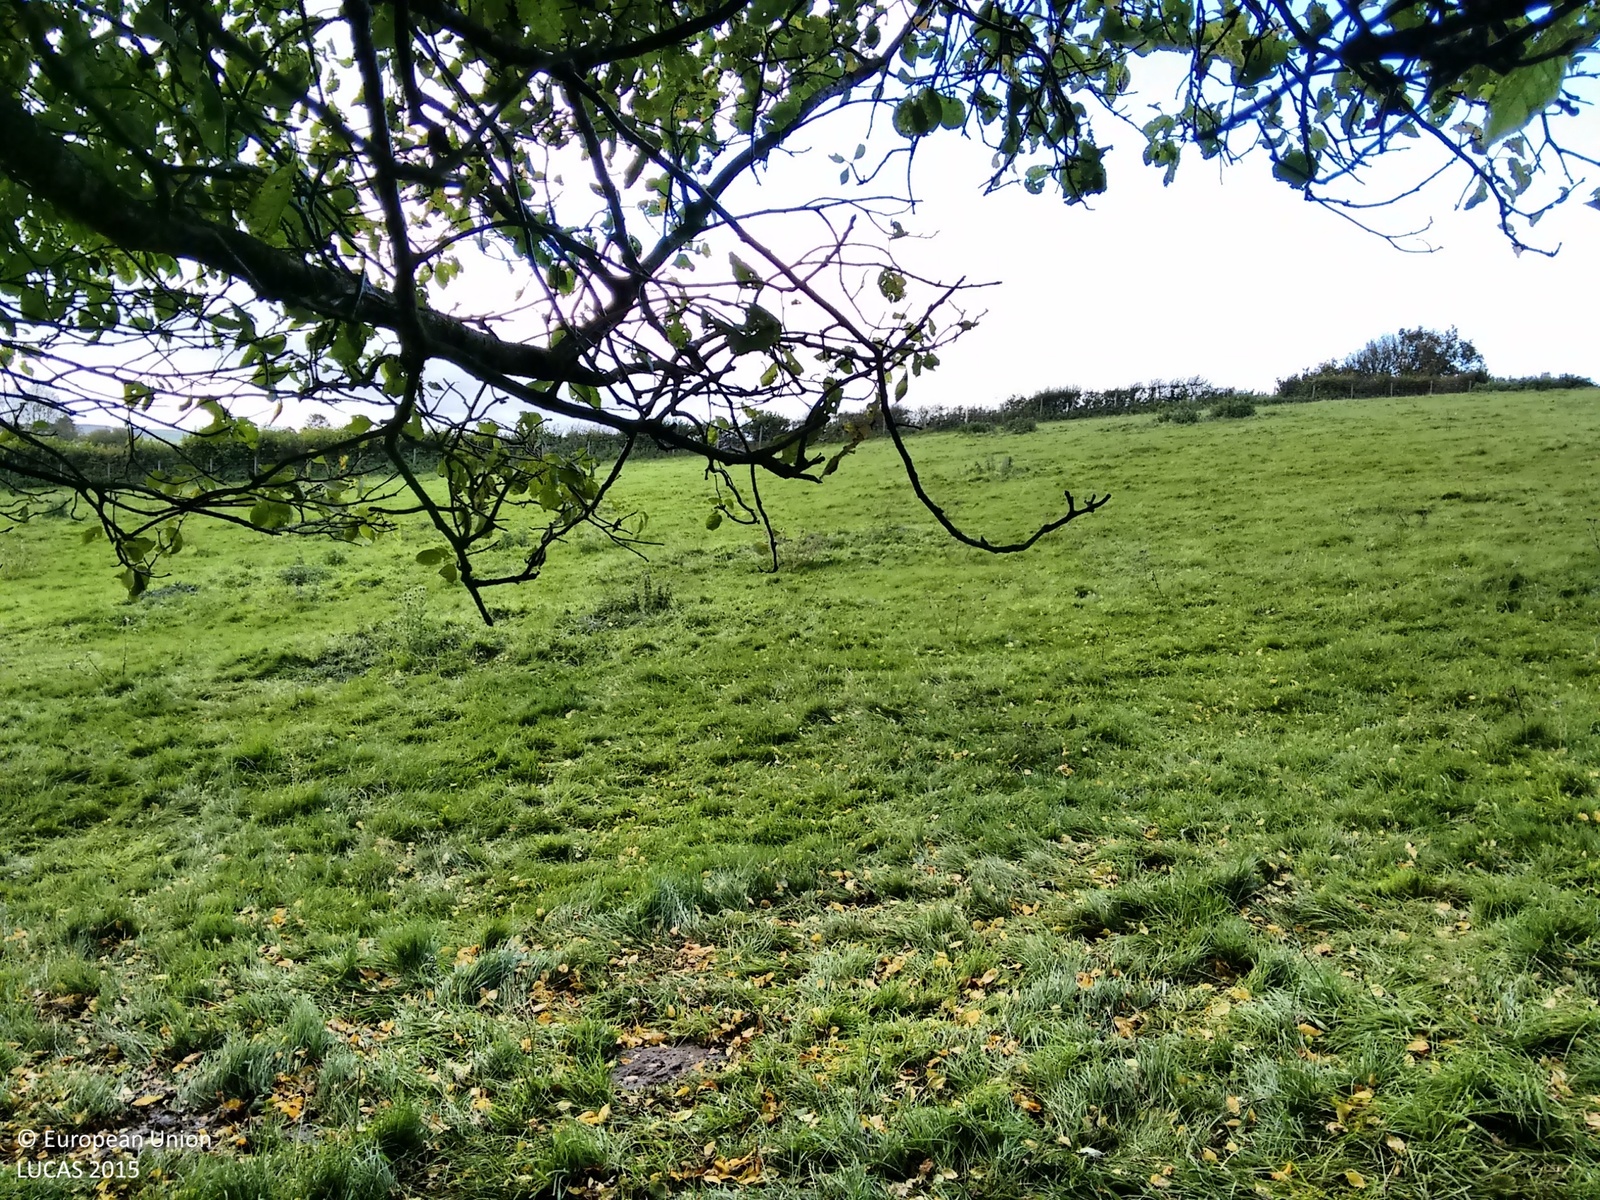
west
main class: Grassland
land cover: Grassland without tree/shrub cover
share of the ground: > 75 %
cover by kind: herbaceous plants 100 %
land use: Agriculture (excluding fallow land and kitchen gardens)
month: October
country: GB
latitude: 52.3706
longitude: -3.3144
